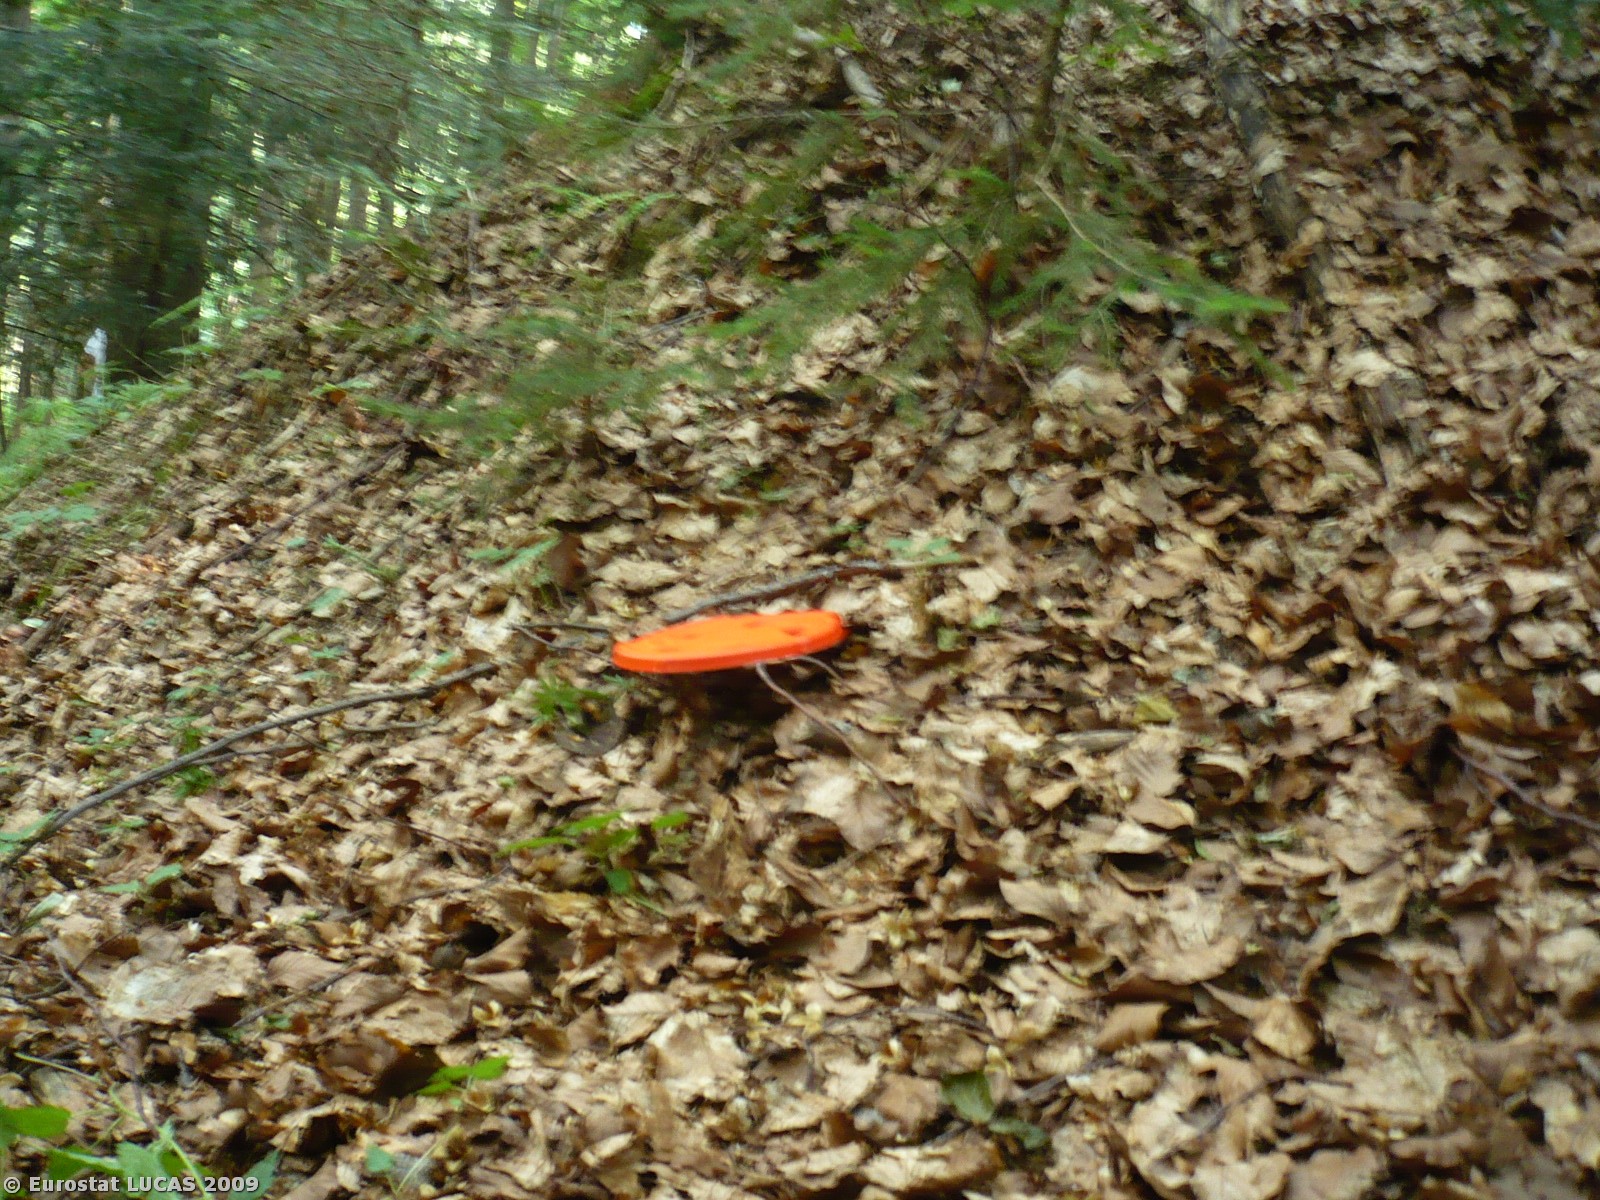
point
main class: Woodland
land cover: Mixed woodland
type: beech forest
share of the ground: > 75 %
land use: Forestry
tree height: > 5 m
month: August
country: SI
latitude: 46.3058
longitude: 15.3864
